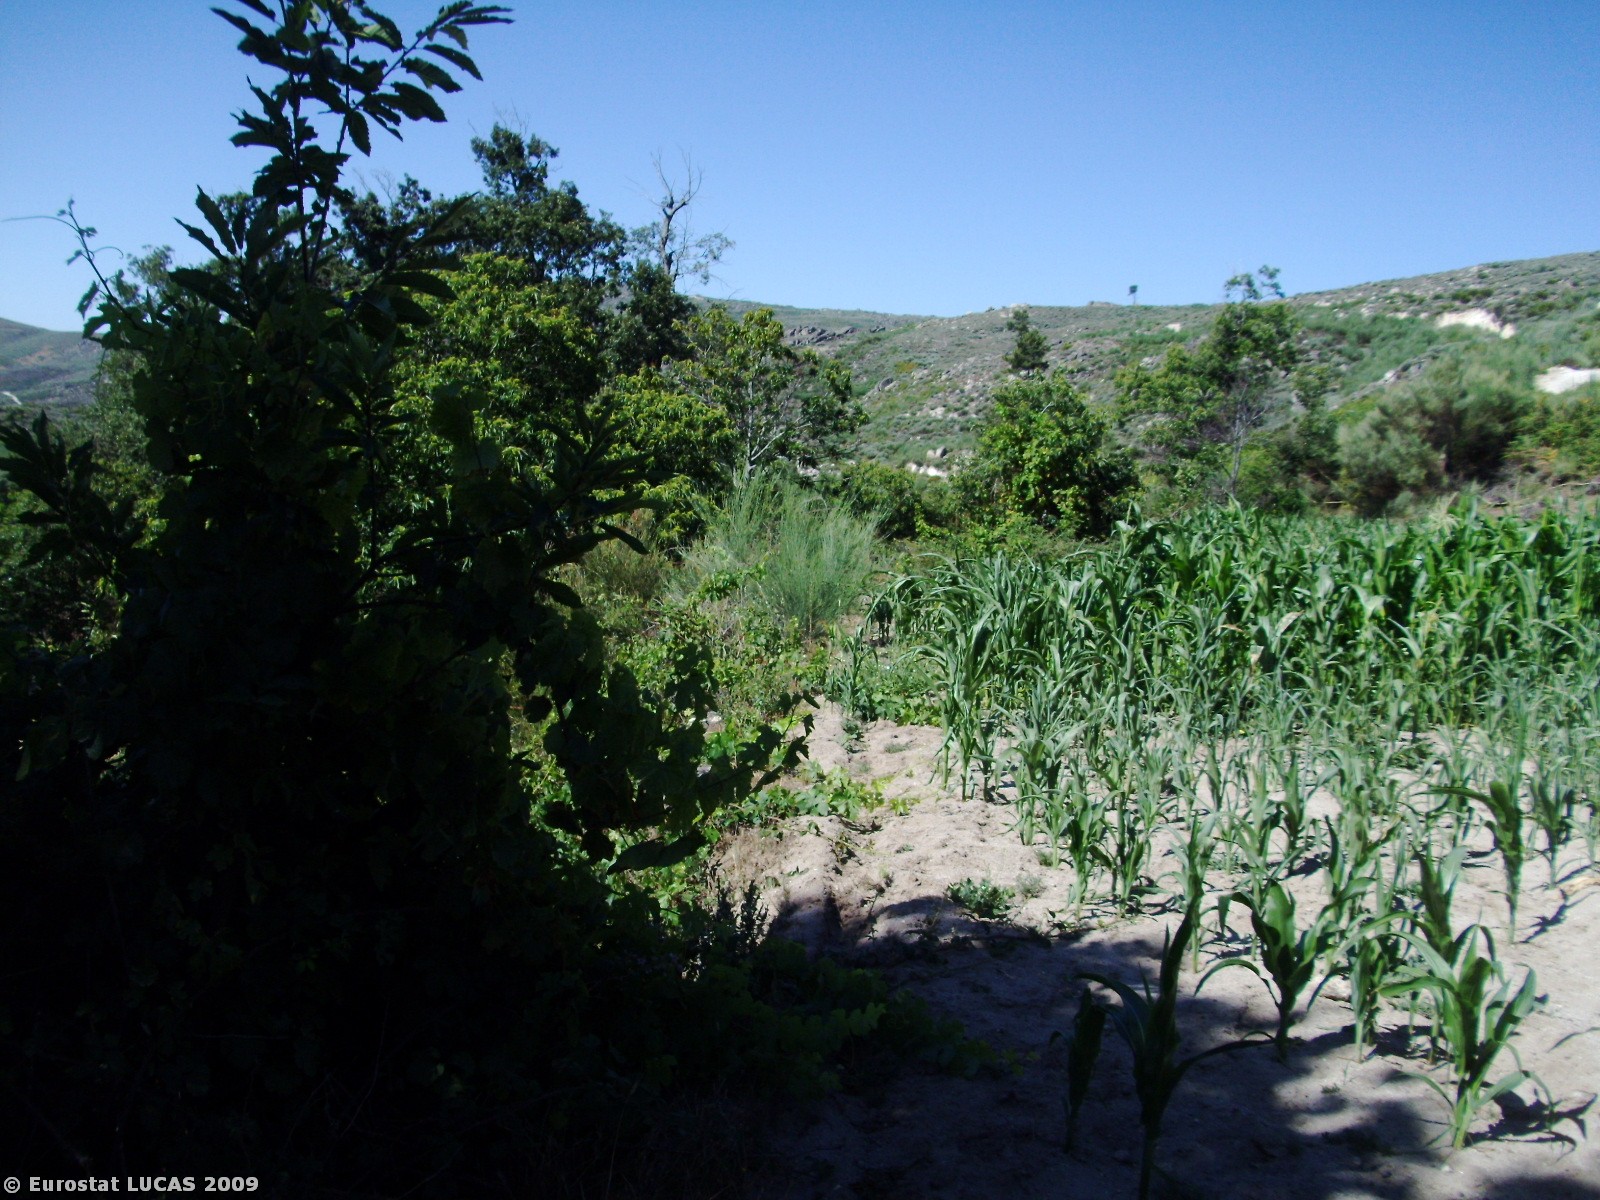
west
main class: Cropland
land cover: Maize
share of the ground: > 75 %
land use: Agriculture (excluding fallow land and kitchen gardens)
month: July
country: PT
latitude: 40.4850
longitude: -7.3183
